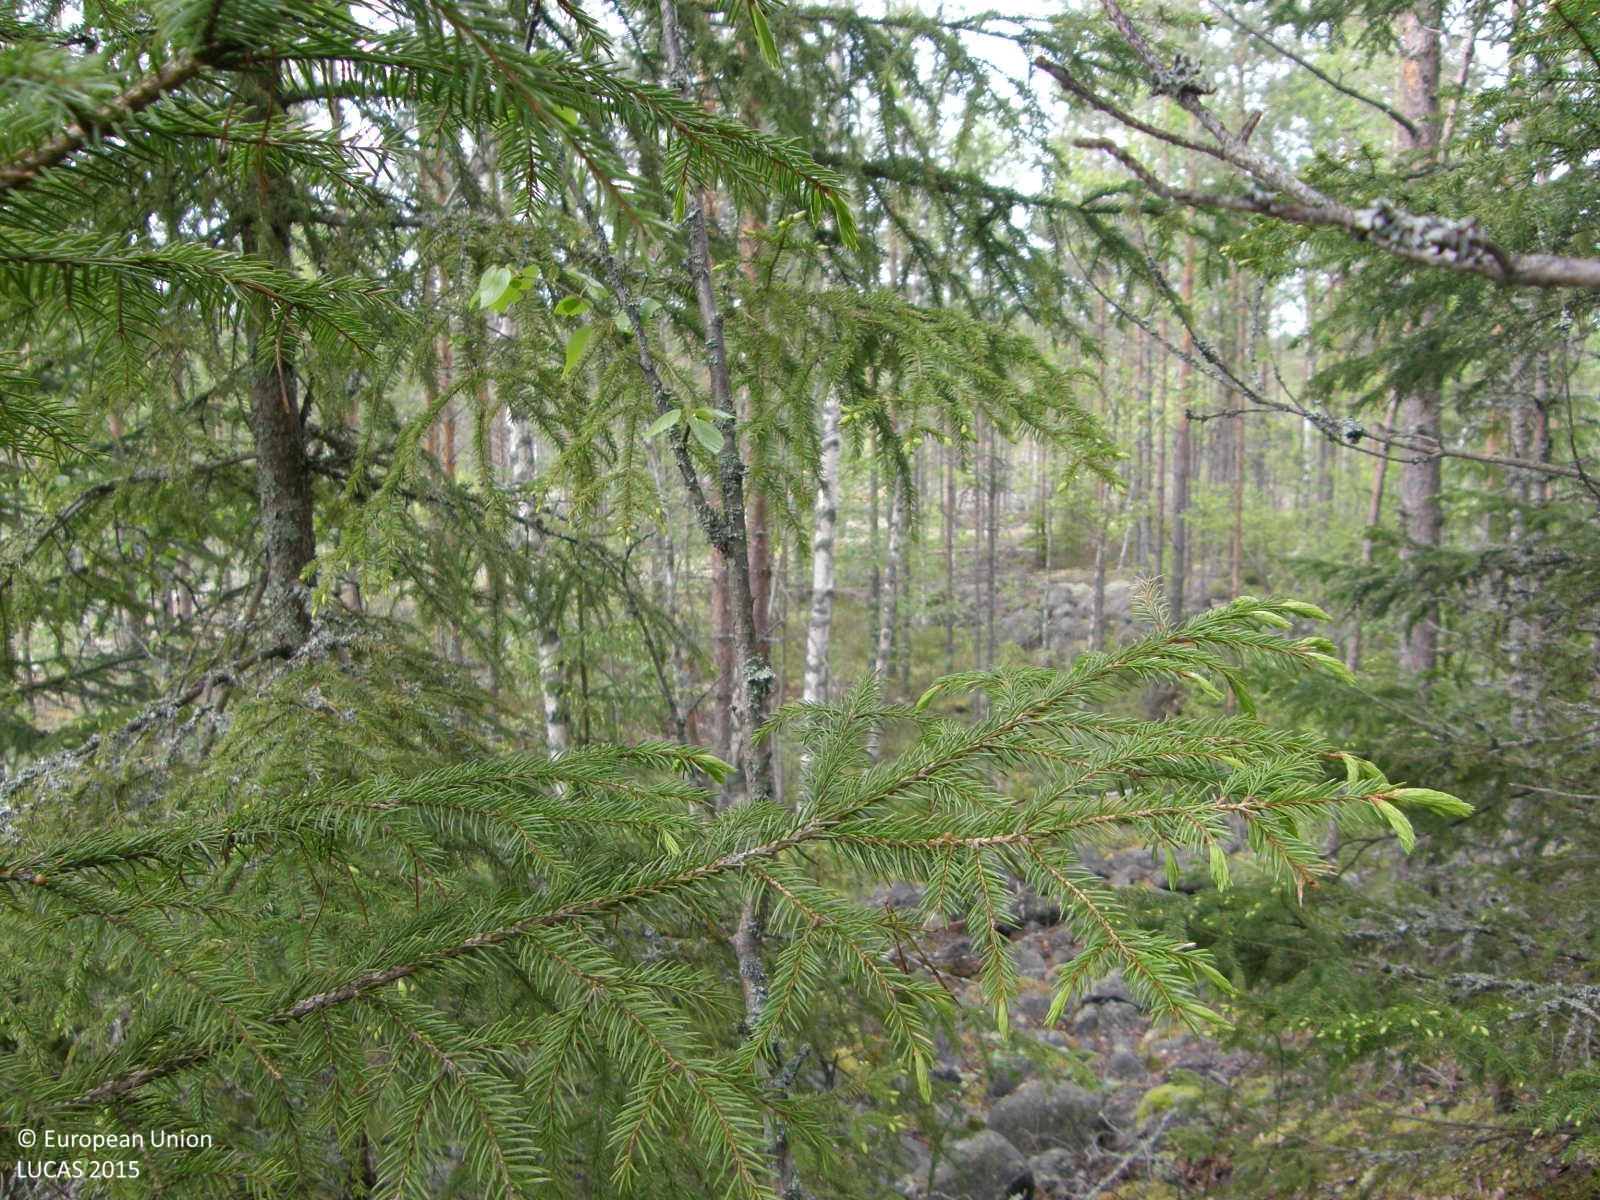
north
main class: Woodland
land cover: Pine dominated mixed woodland
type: boreal forest
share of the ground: > 75 %
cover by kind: coniferous forest trees 65 %, broadleaved forest trees 25 %, consolidated bare surface 5 %, unconsolidated bare surface 5 %
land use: Forestry
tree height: > 5 m
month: June
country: FI
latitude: 61.9391
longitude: 21.6542
